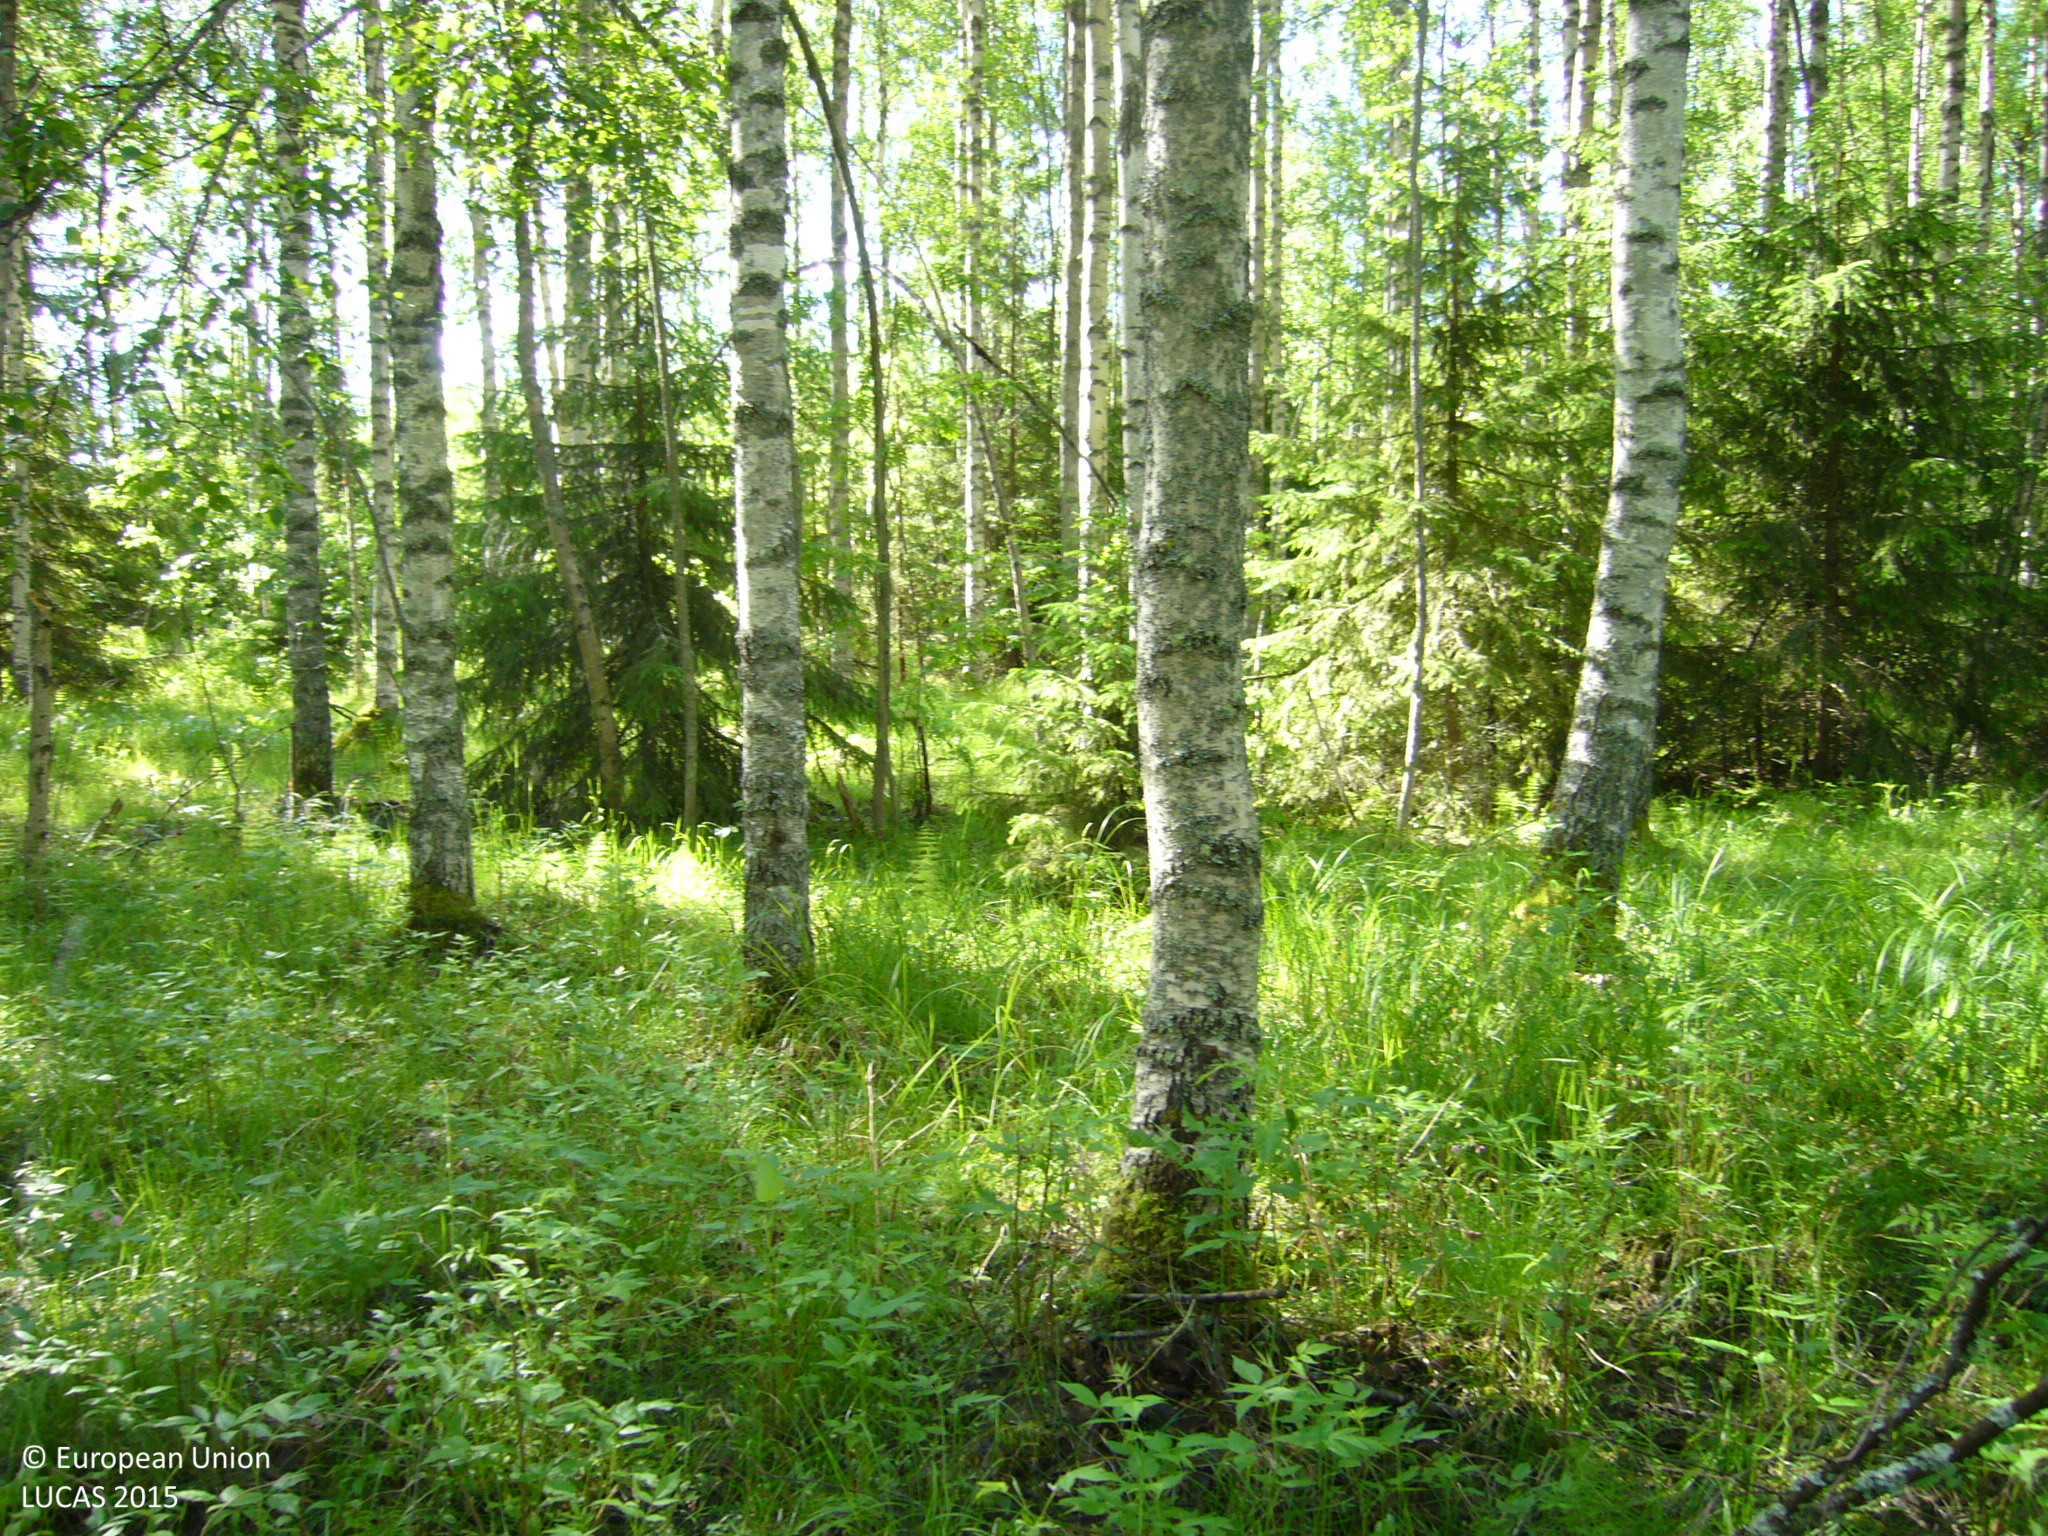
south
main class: Woodland
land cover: Spruce dominated mixed woodland
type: boreal forest
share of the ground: > 75 %
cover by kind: broadleaved forest trees 60 %, coniferous forest trees 25 %, shrubs 15 %
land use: Forestry
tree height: > 5 m
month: June
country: FI
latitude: 63.8240
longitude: 26.4784
